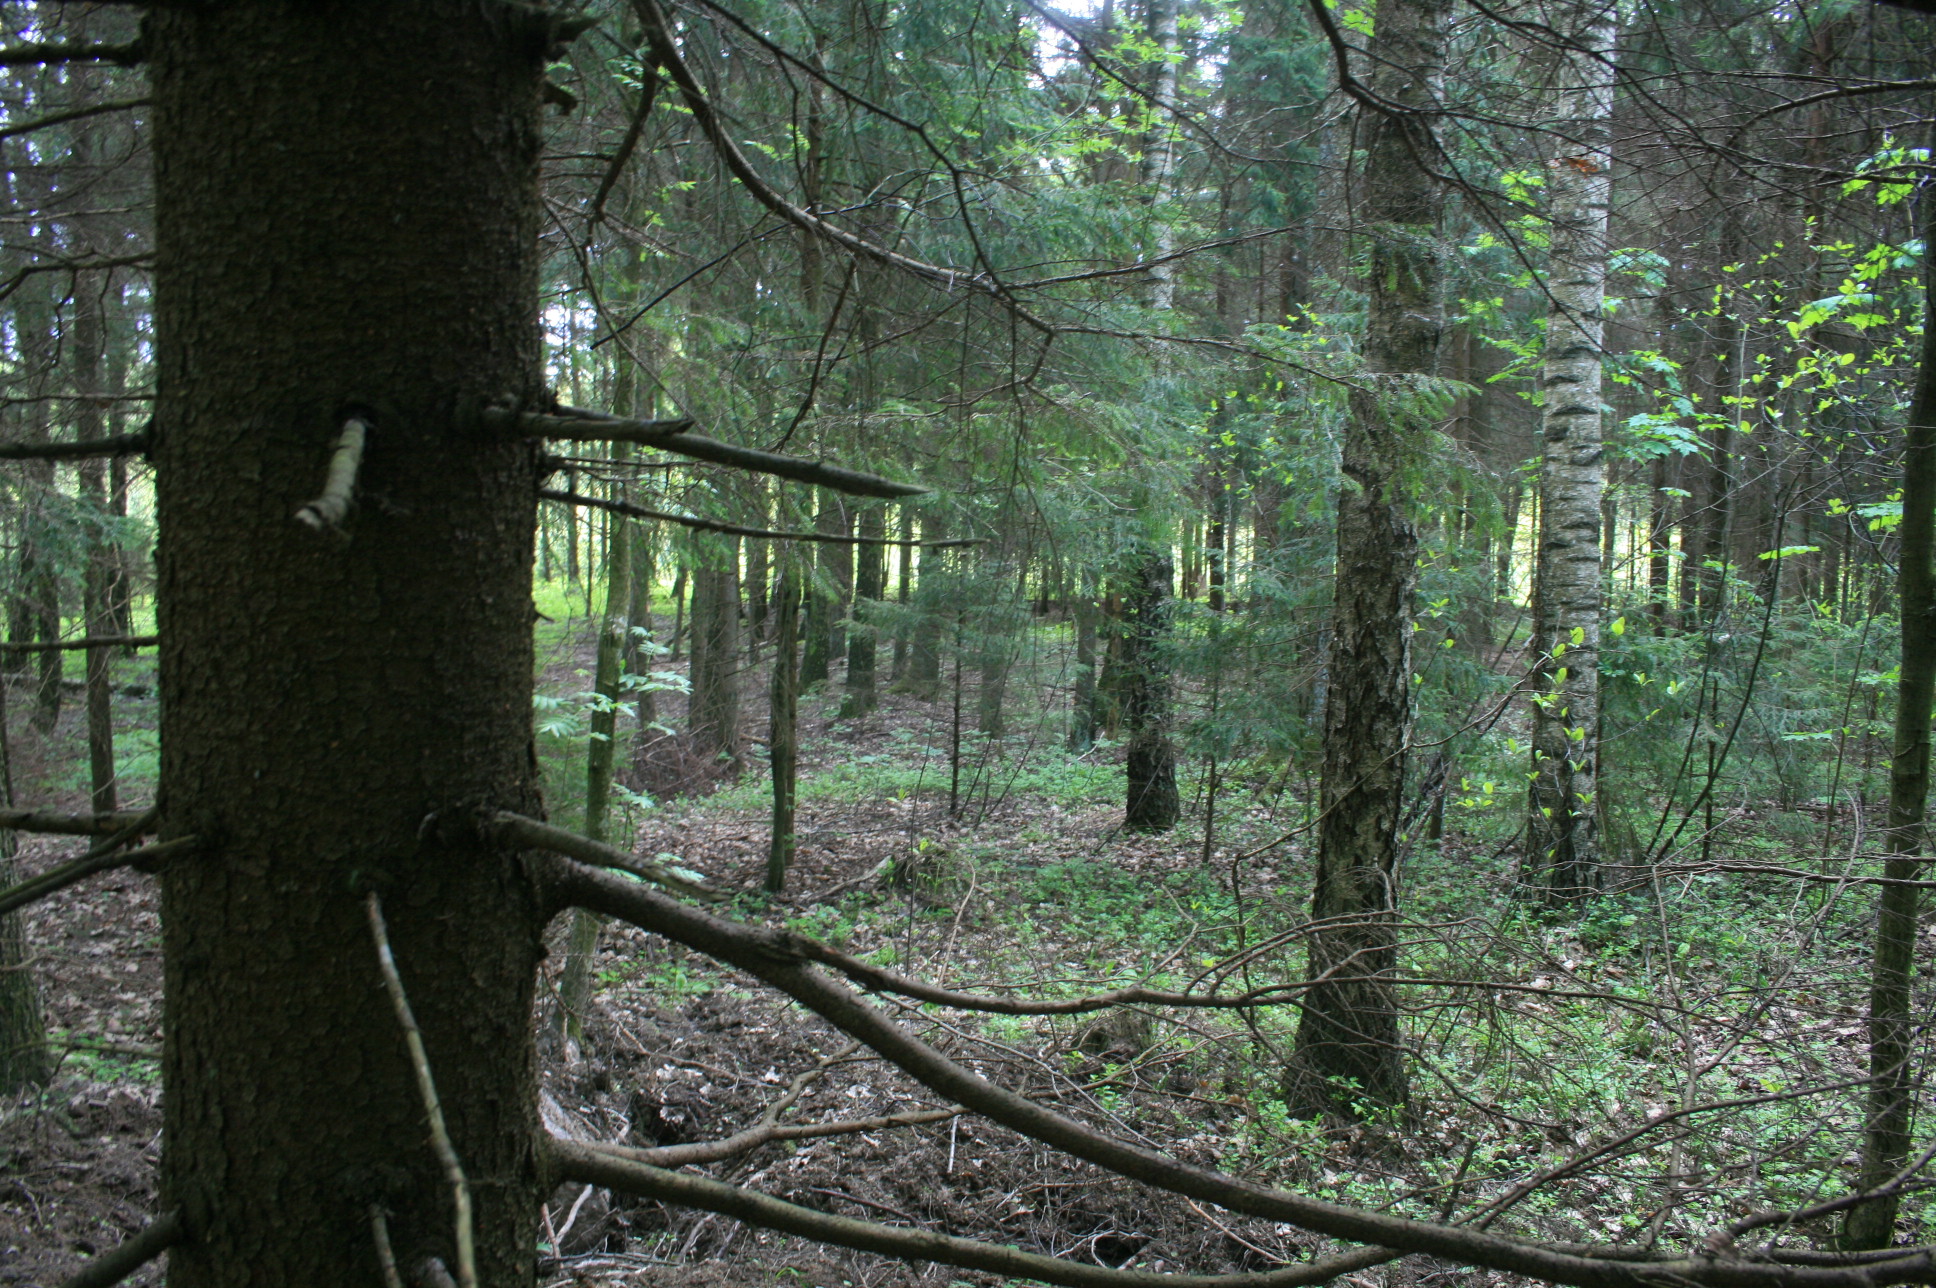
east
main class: Woodland
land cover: Spruce dominated mixed woodland
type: hemiboreal forest and nemoral coniferous forest and mixed broadleaved-coniferous forest
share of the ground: > 75 %
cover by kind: coniferous forest trees 70 %, broadleaved forest trees 30 %
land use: Forestry
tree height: > 5 m
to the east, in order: Spruce dominated mixed woodland; Pine dominated coniferous woodland; Spruce dominated mixed woodland; Other coniferous woodland
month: May
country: LT
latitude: 55.7629
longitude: 21.8595
